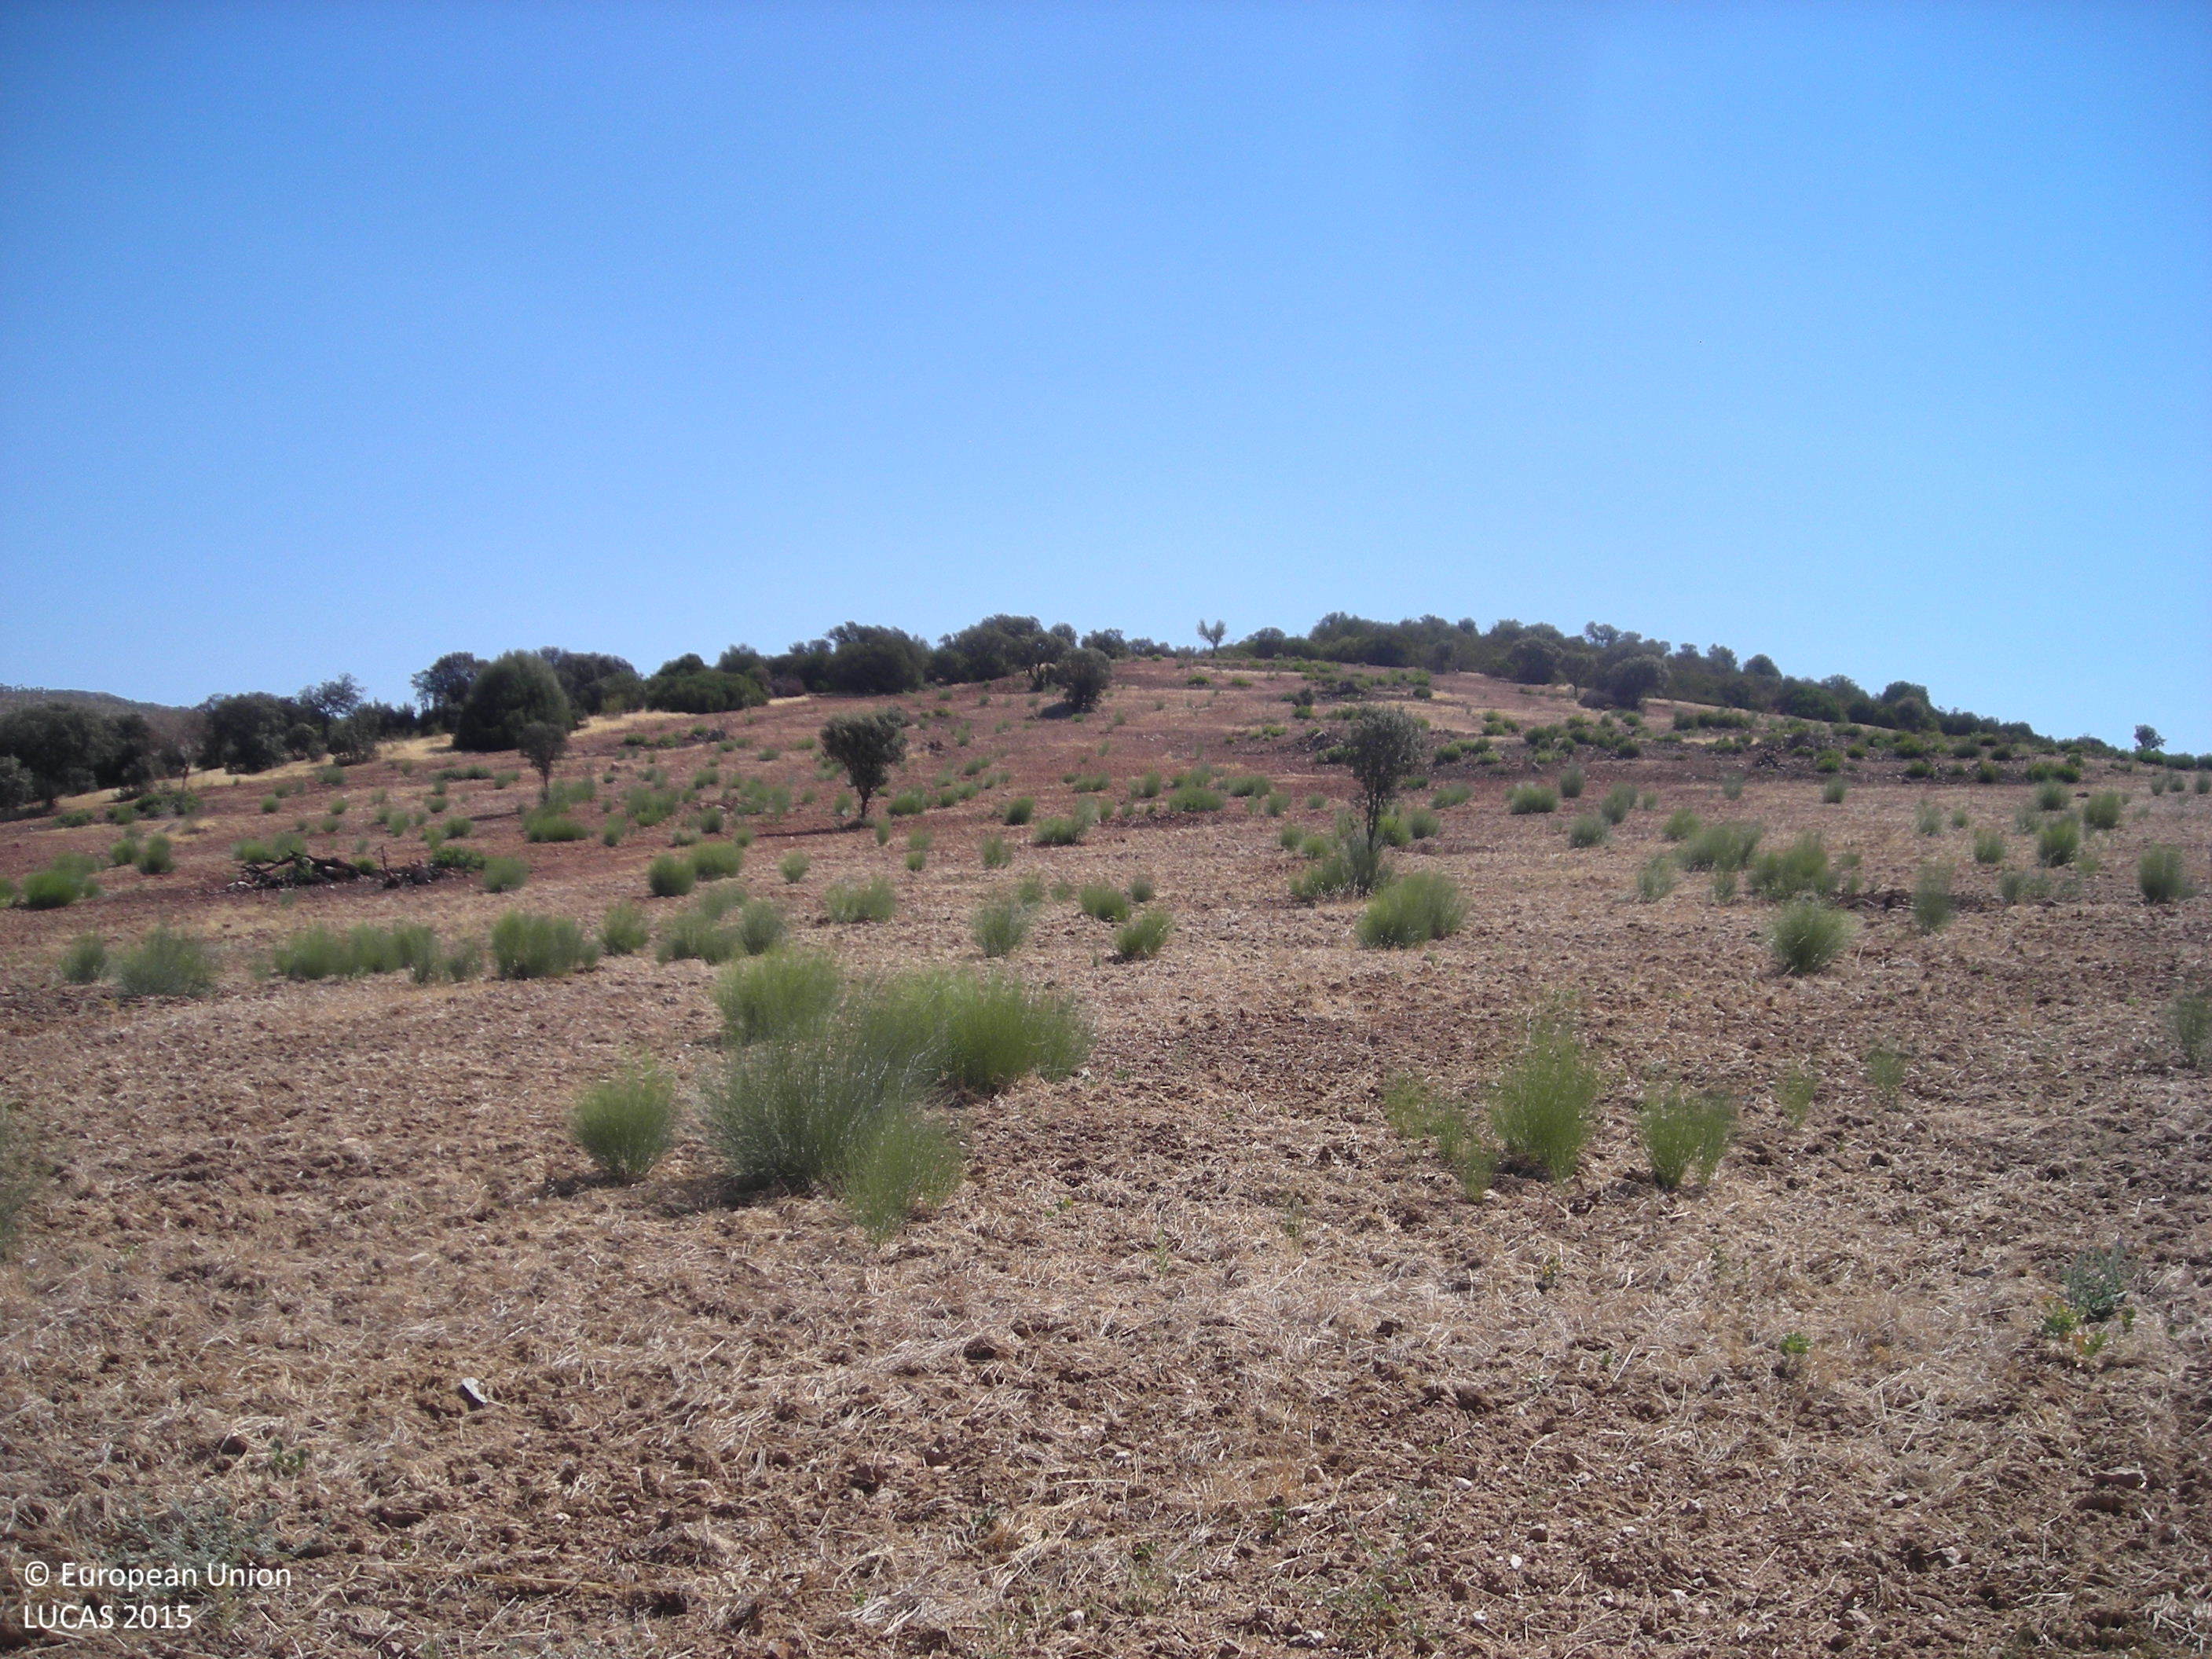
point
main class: Grassland
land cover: Grassland with sparse tree/shrub cover
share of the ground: > 75 %
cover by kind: herbaceous plants 85 %, shrubs 10 %, broadleaved forest trees 5 %
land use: Agriculture (excluding fallow land and kitchen gardens)
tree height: > 5 m
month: July
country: ES
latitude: 38.7954
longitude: -5.9016
